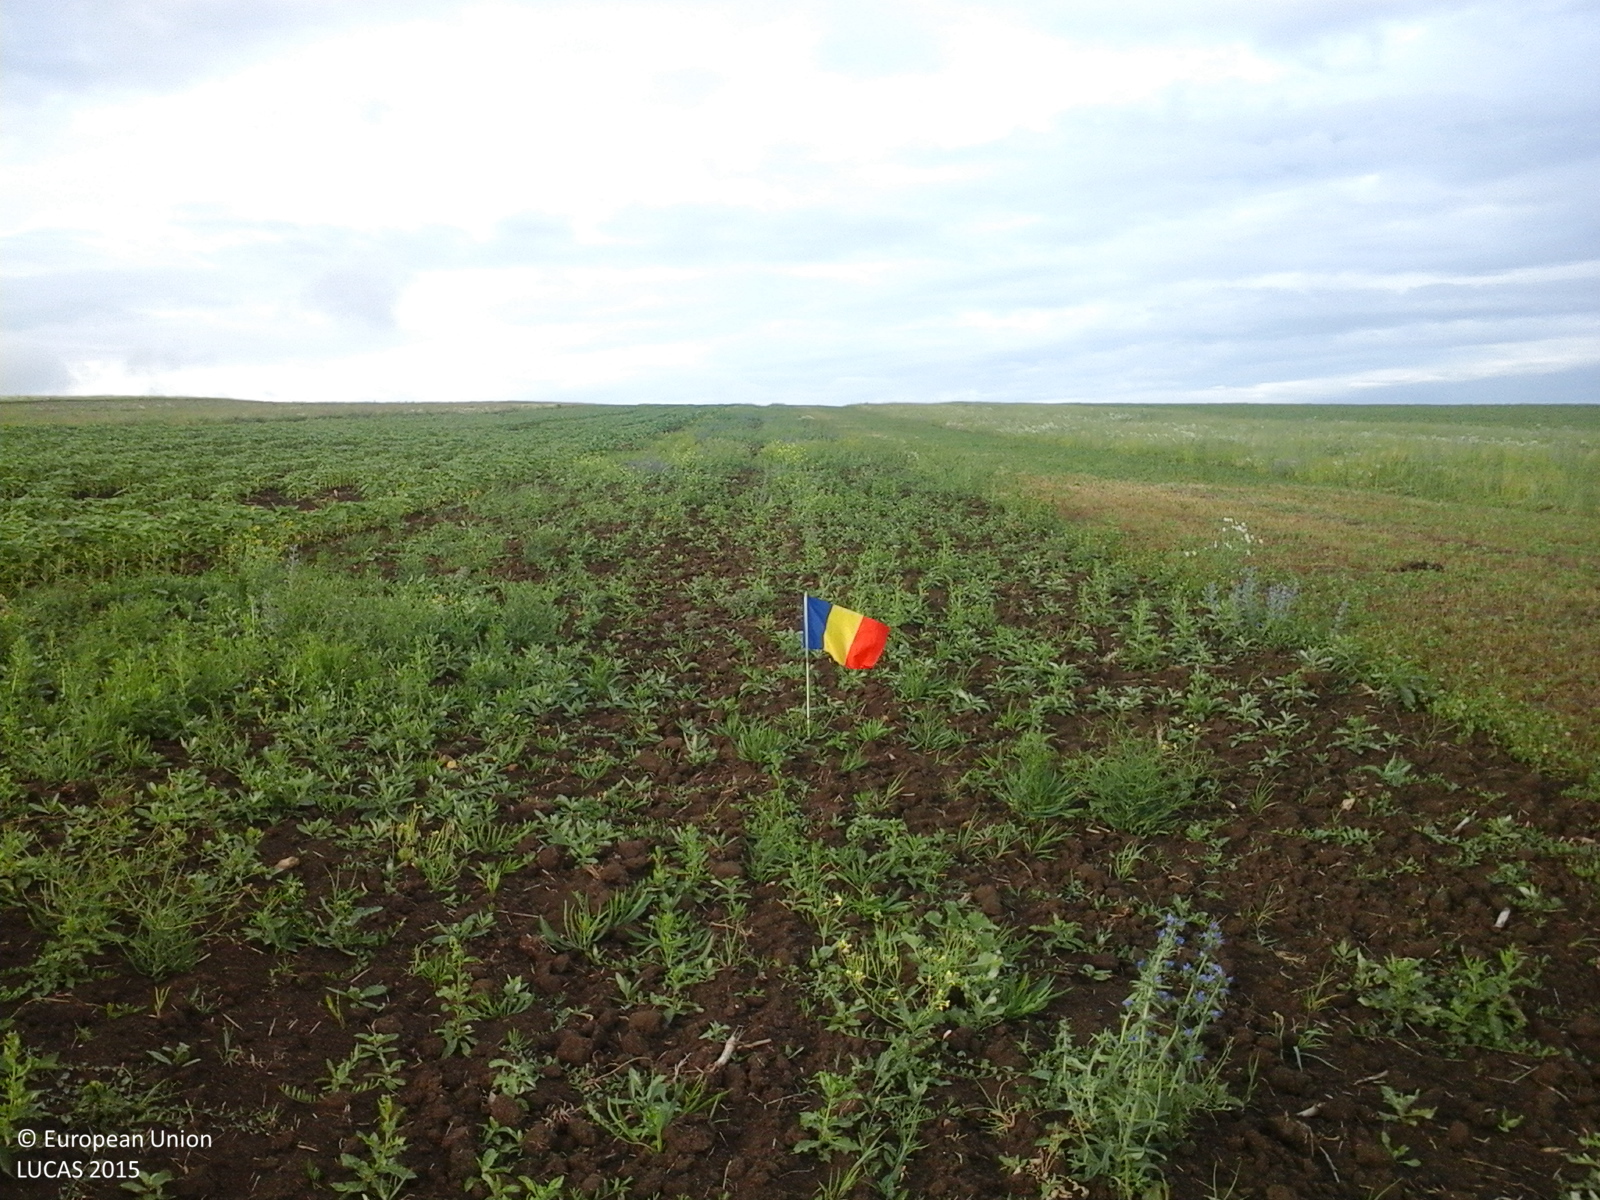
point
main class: Grassland
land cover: Spontaneously vegetated surfaces
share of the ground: 50 - 75 %
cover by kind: herbaceous plants 100 %
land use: Fallow land
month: June
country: RO
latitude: 47.2900
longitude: 26.7961
